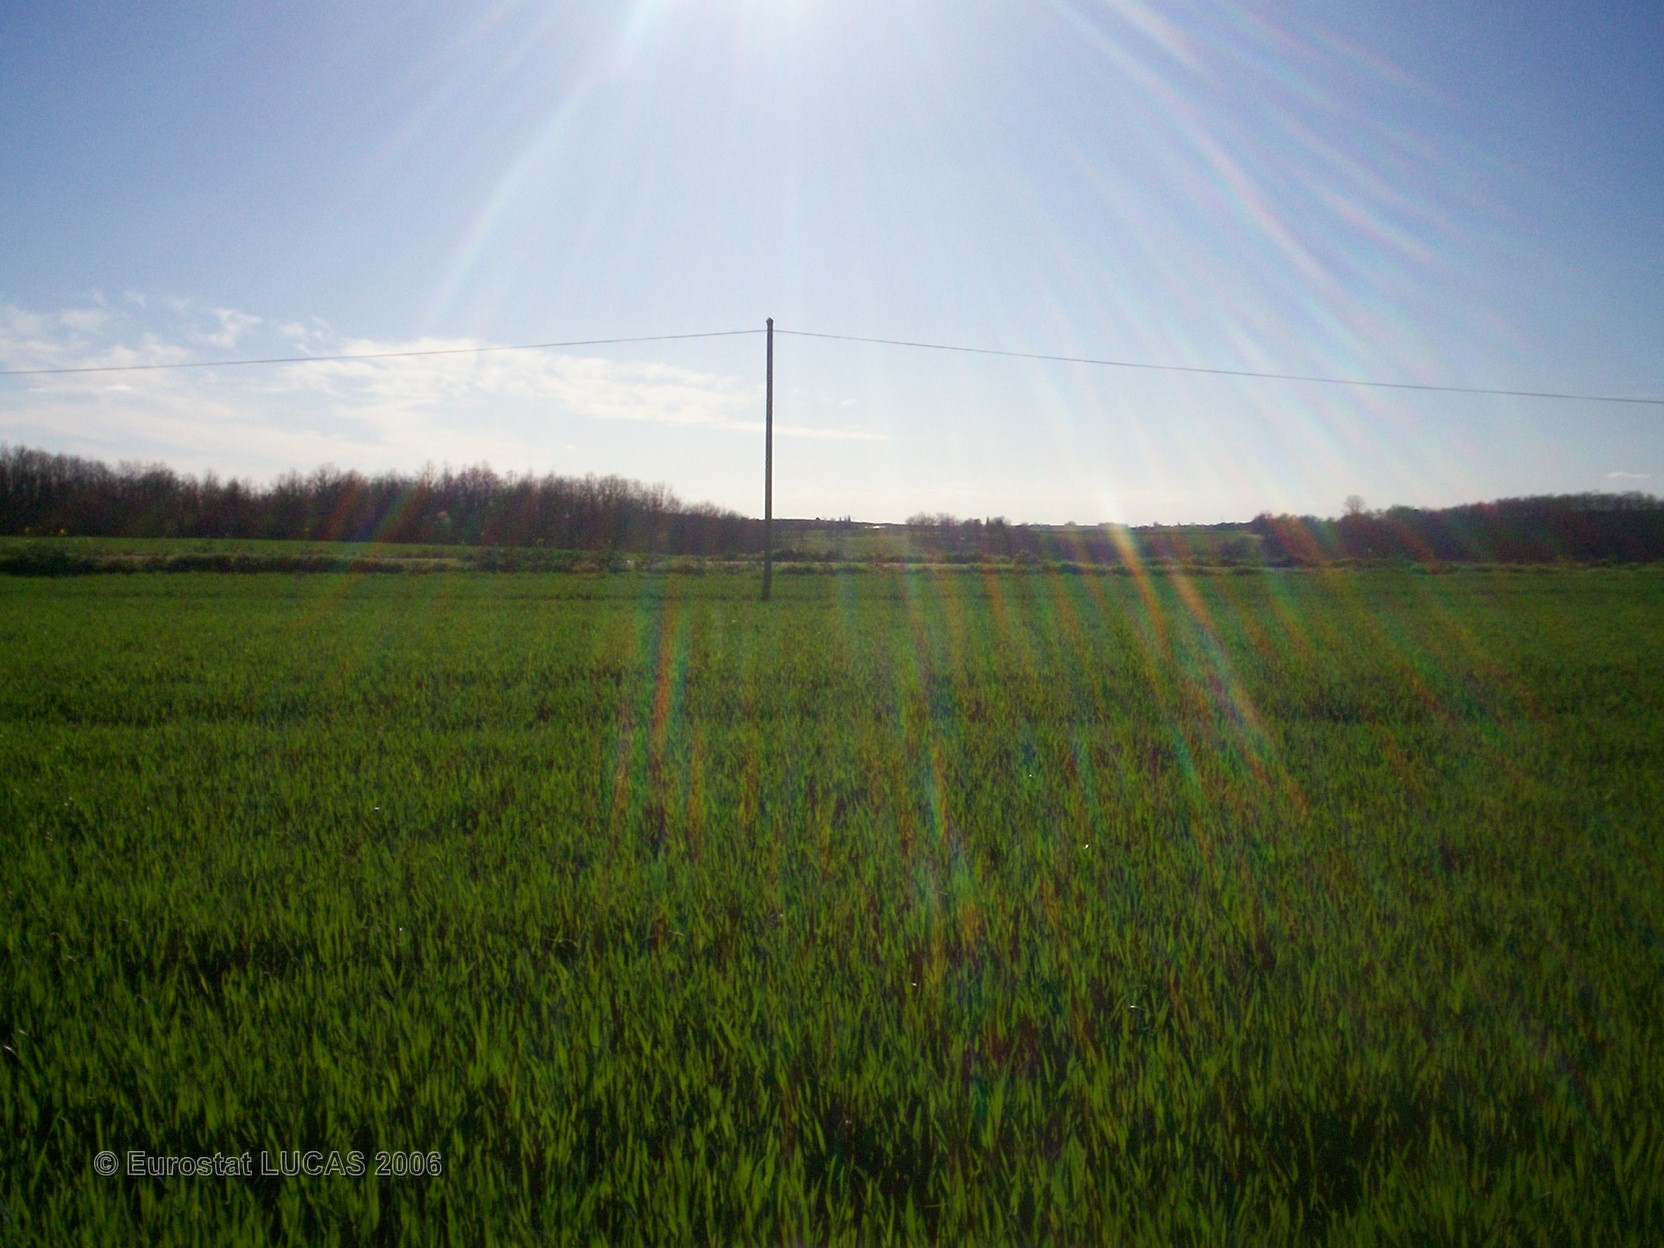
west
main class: Cropland
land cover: Common wheat
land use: Agriculture (excluding fallow land and kitchen gardens)
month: April
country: FR
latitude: 44.2619
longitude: 0.9400
